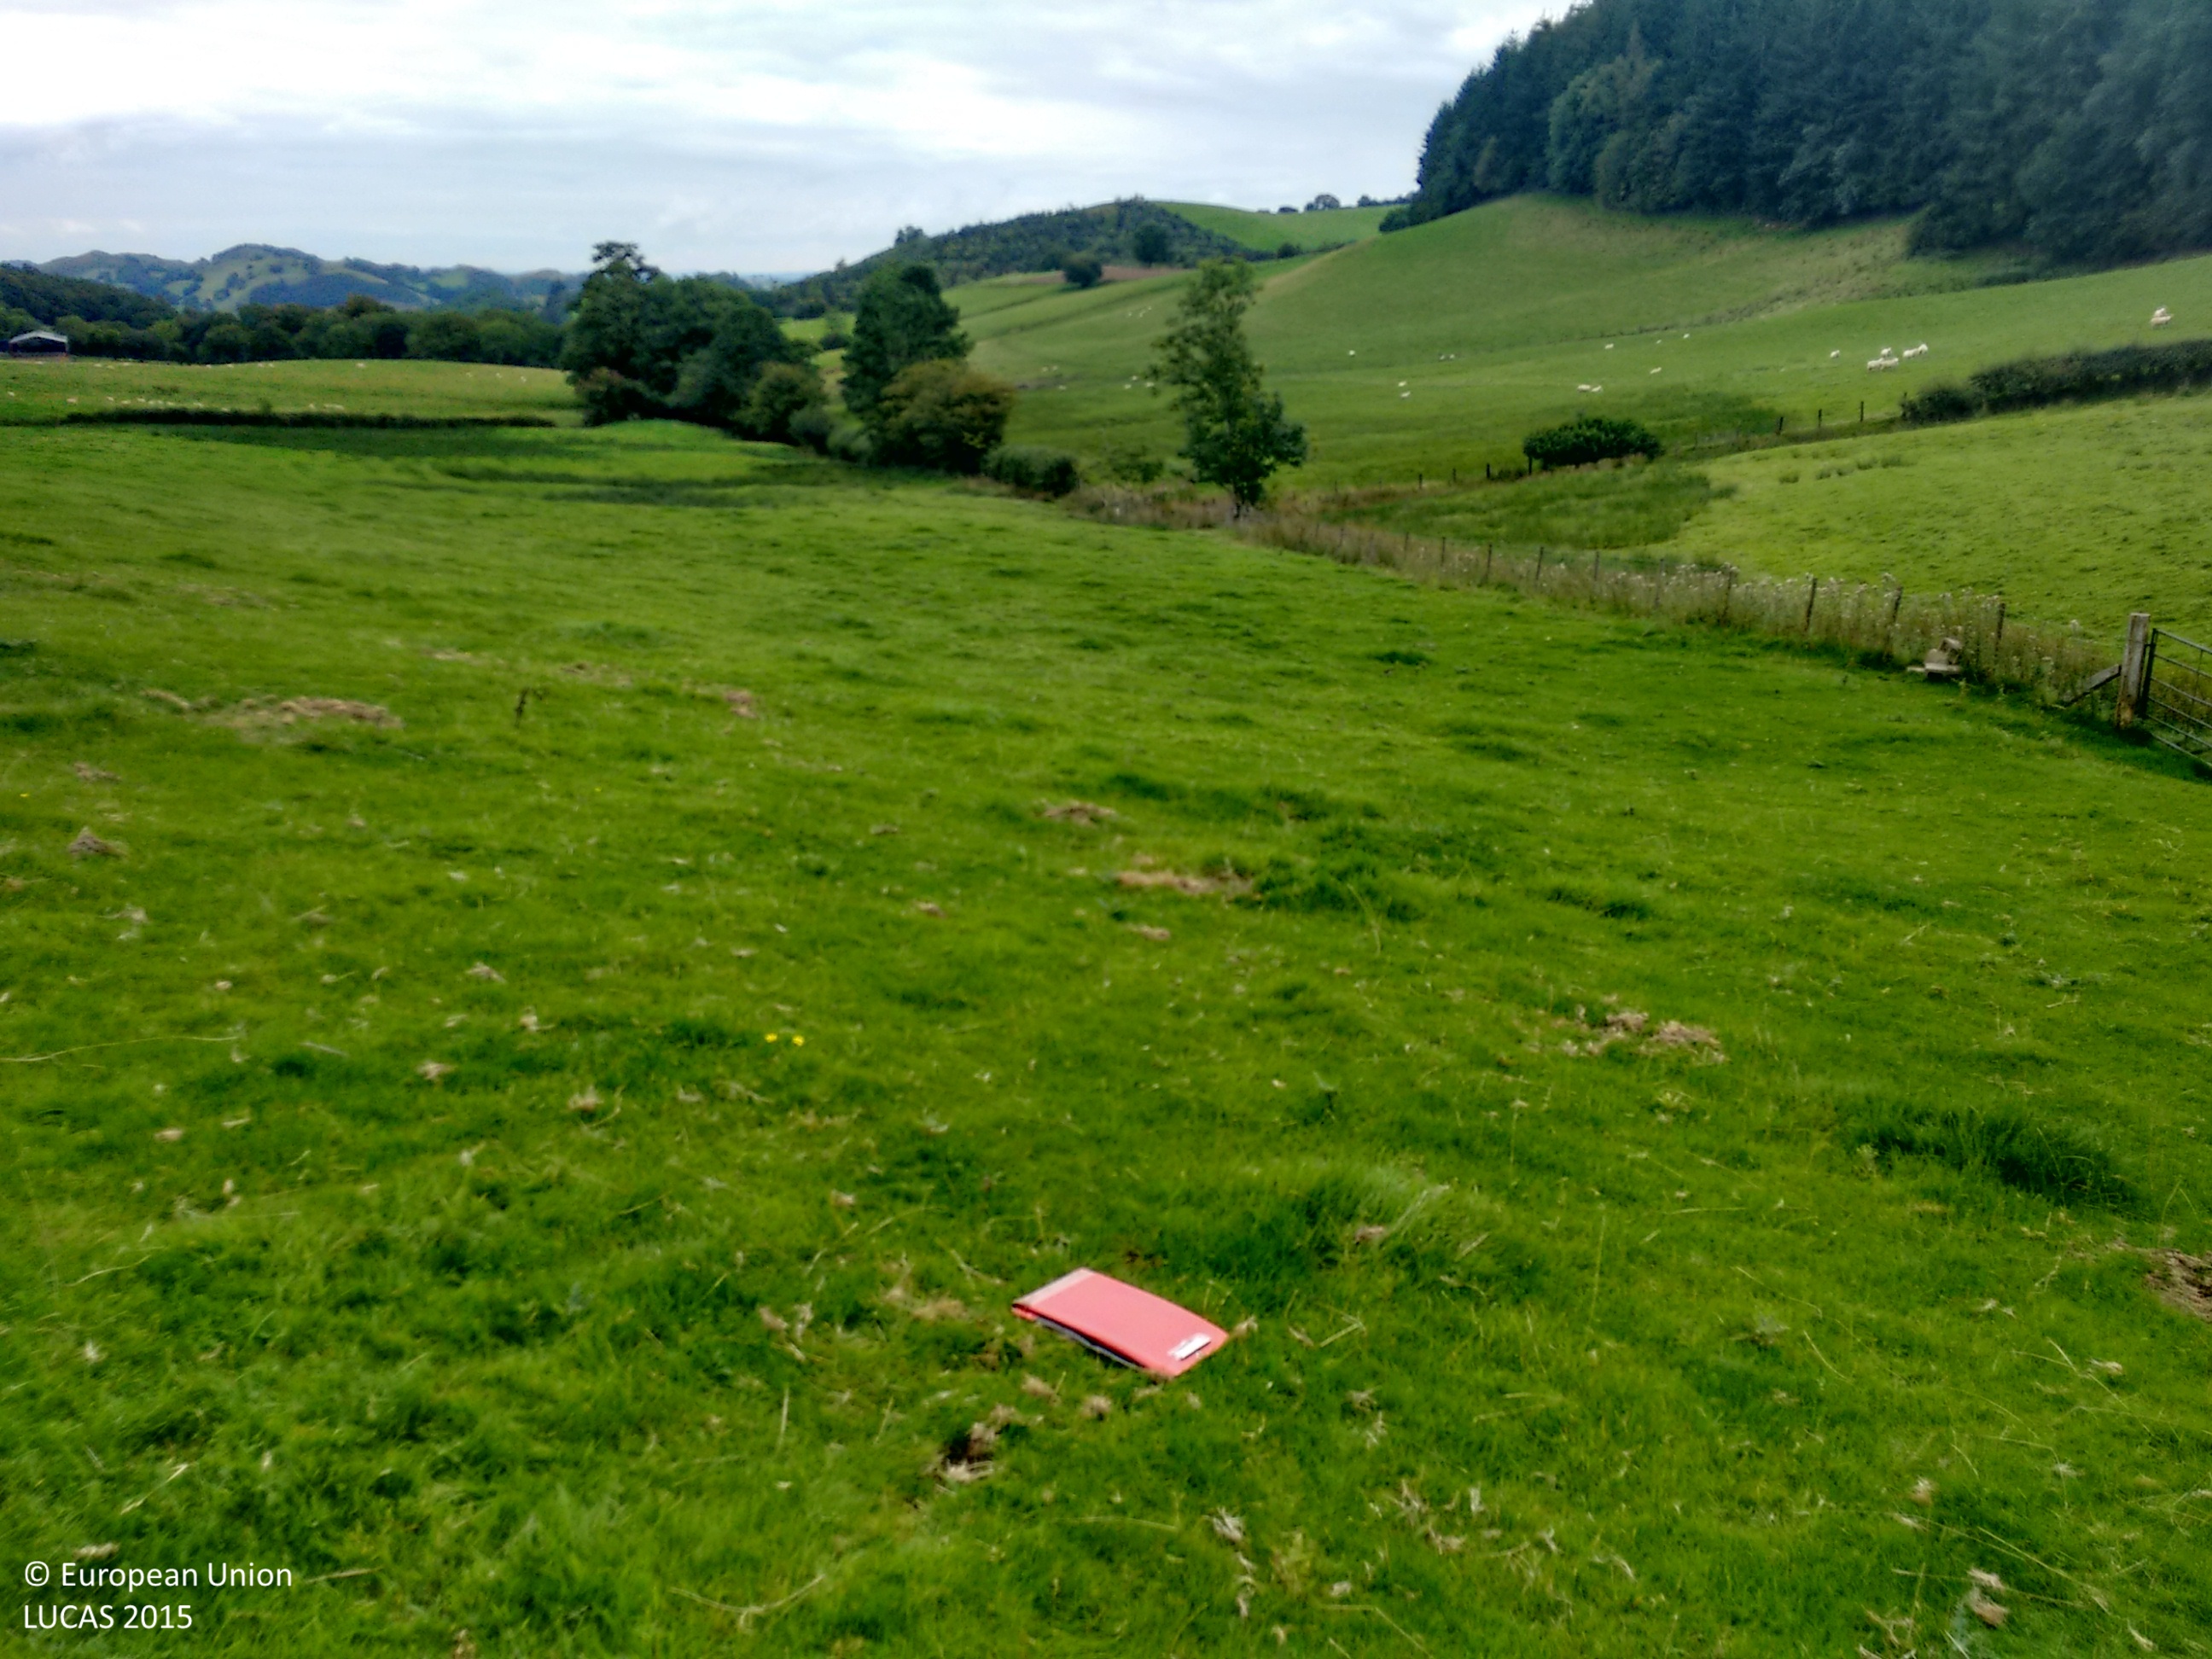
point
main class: Grassland
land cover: Grassland without tree/shrub cover
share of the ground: > 75 %
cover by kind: herbaceous plants 100 %
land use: Agriculture (excluding fallow land and kitchen gardens)
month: September
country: GB
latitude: 52.7538
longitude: -3.3116
